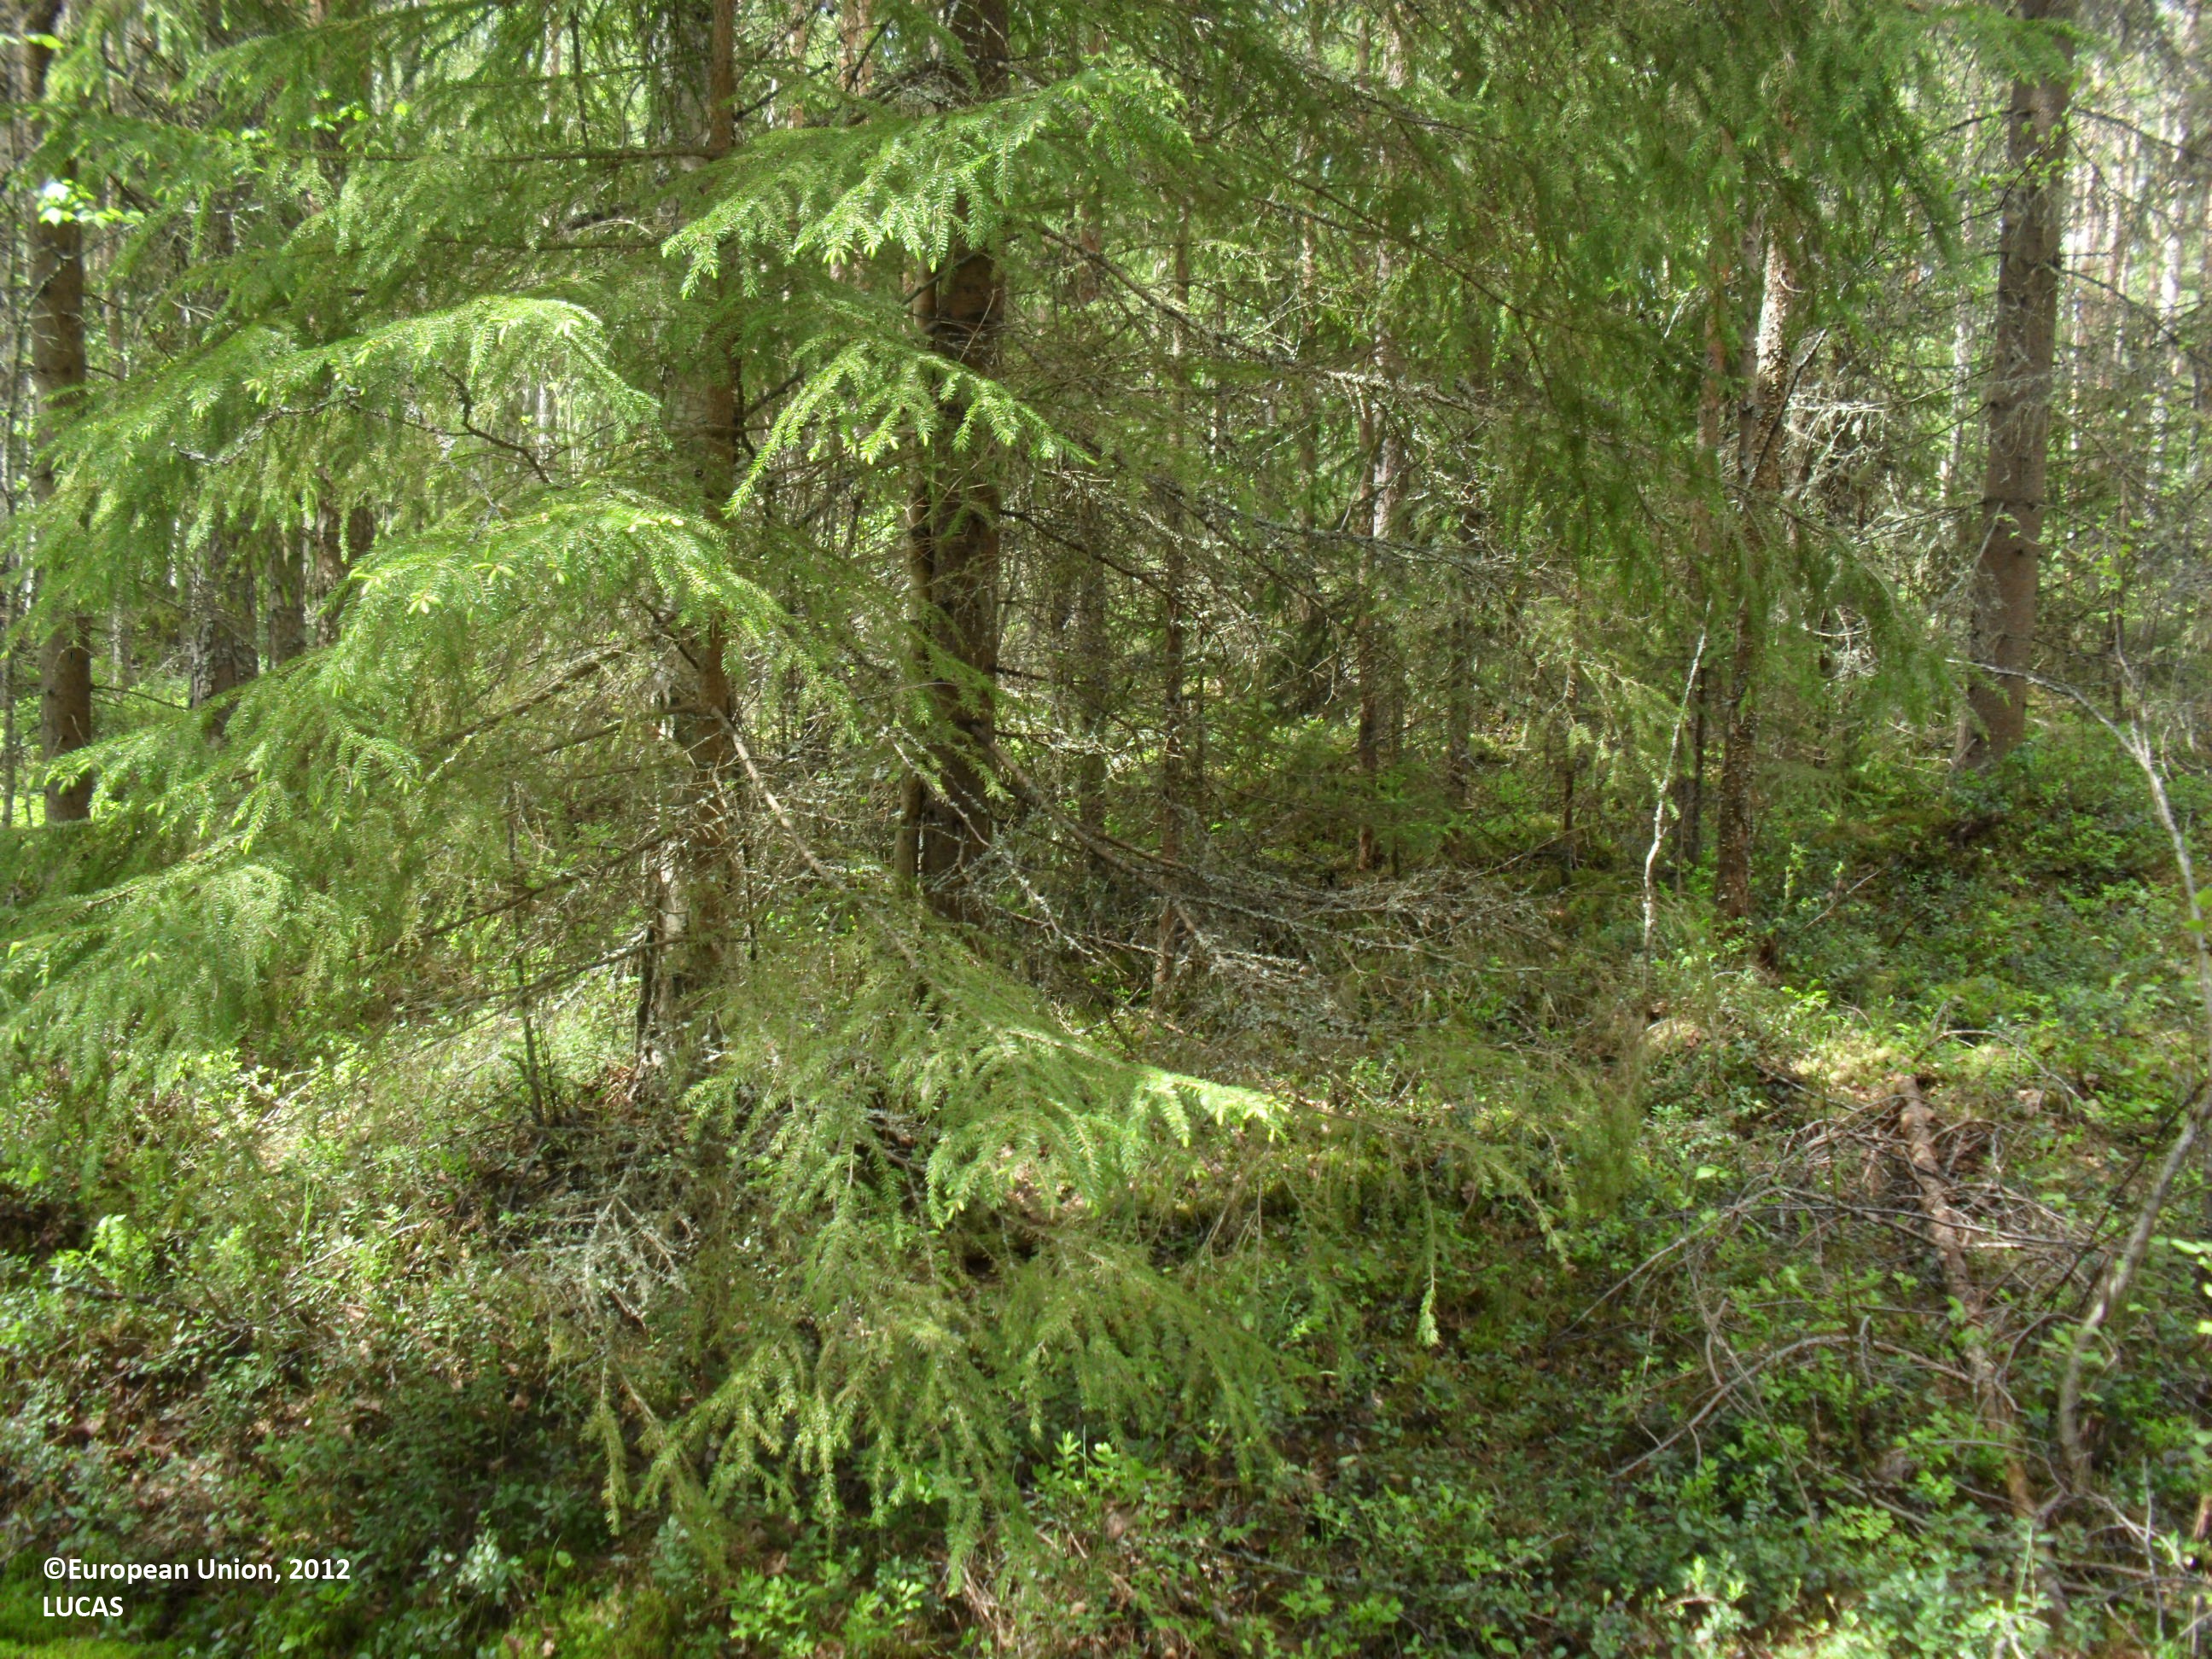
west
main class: Woodland
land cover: Spruce dominated mixed woodland
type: boreal forest
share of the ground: > 75 %
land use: Forestry
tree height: > 5 m
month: June
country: FI
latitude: 62.8742
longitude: 23.3750
